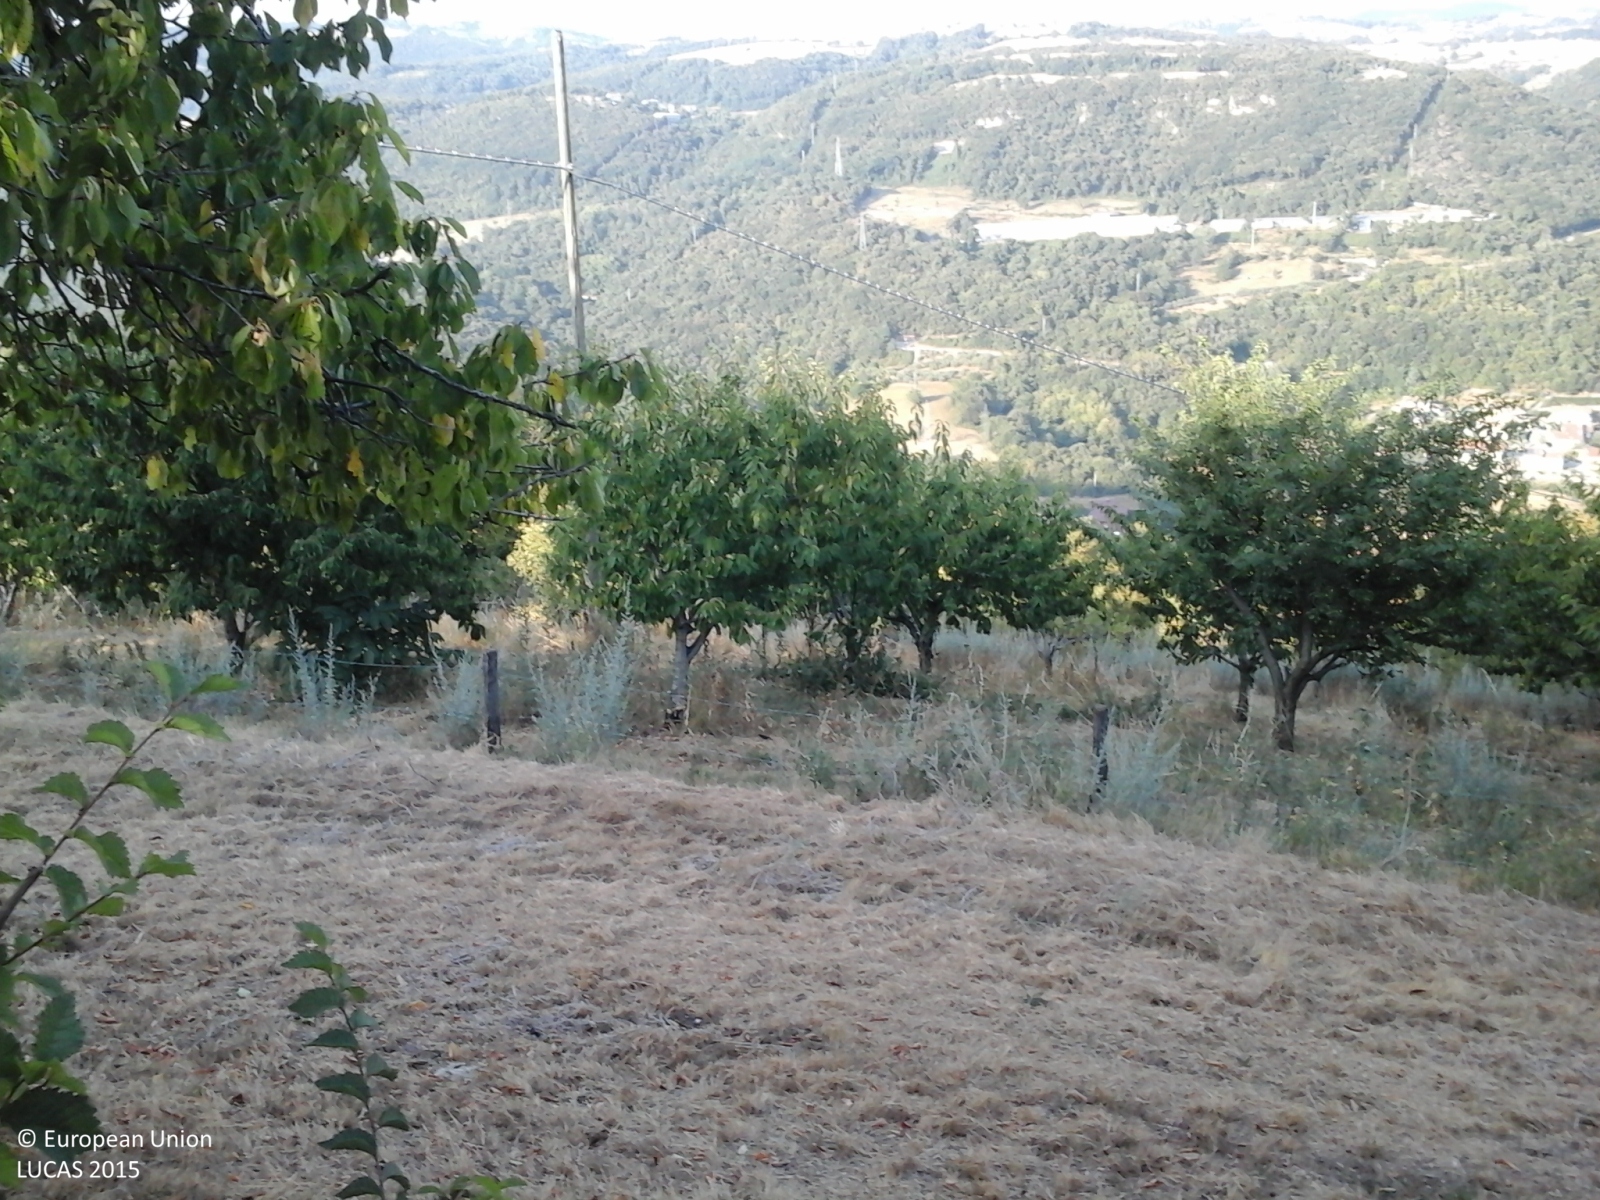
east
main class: Cropland
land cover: Cherry fruit
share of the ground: 50 - 75 %
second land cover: Grassland without tree/shrub cover
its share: > 75 %
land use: Agriculture (excluding fallow land and kitchen gardens)
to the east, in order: Cherry fruit; Grassland without tree/shrub cover; Fences; Cherry fruit; Fences; Cherry fruit; Spontaneously vegetated surfaces; Tracks; Spontaneously vegetated surfaces; Electric lines; Spontaneously vegetated surfaces; Broadleaved woodland
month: July
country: IT
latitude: 45.5719
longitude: 10.9850
